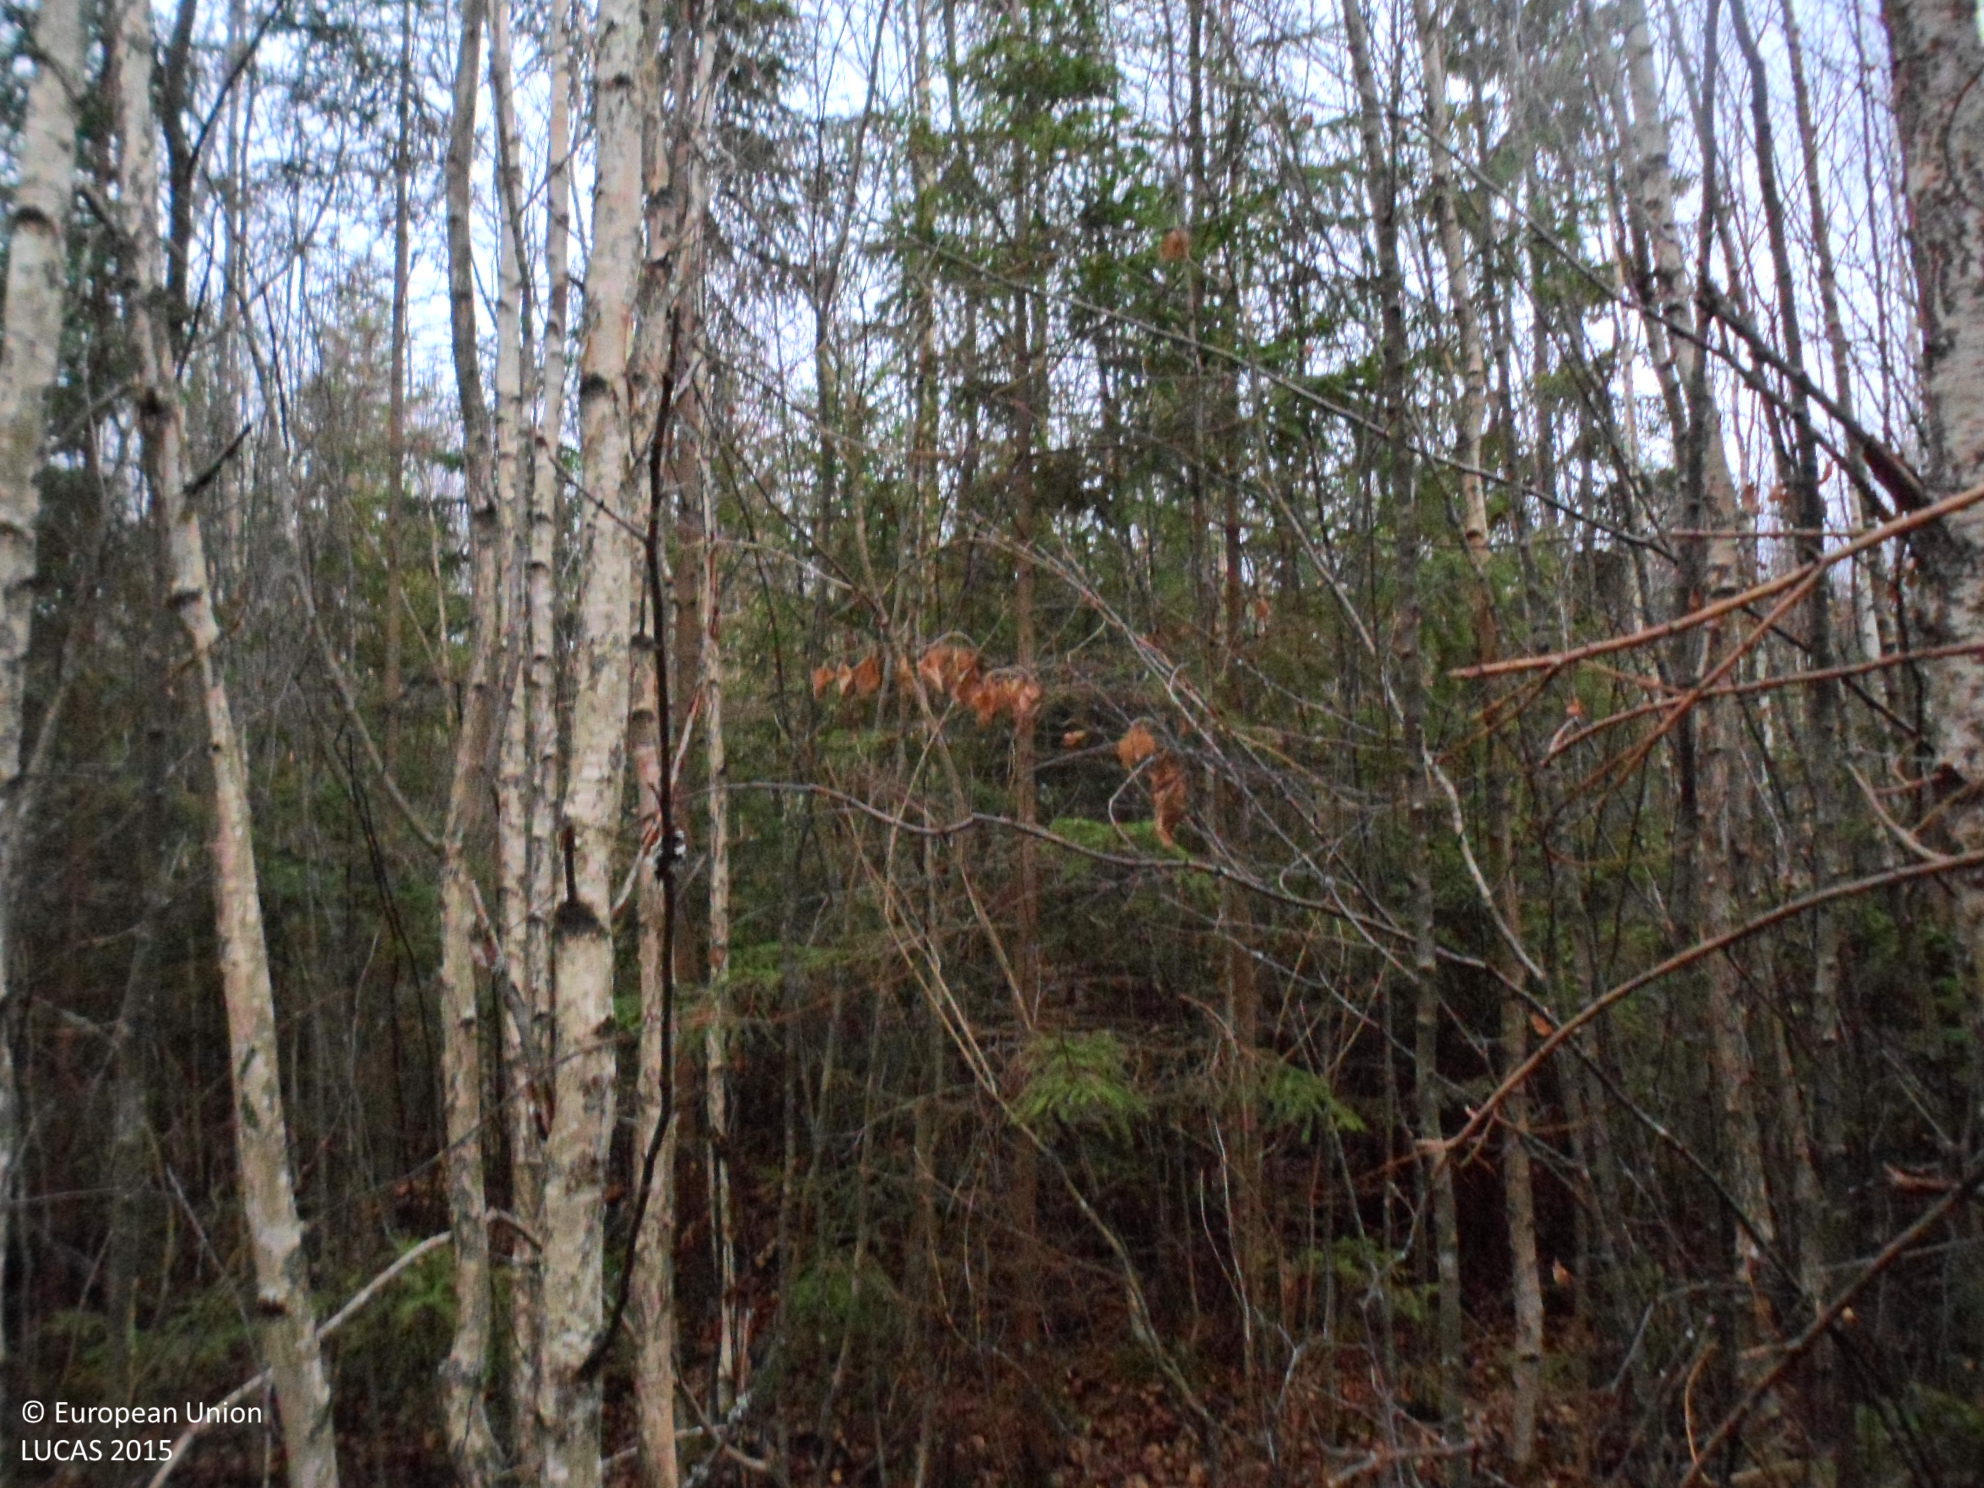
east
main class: Woodland
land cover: Spruce dominated mixed woodland
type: boreal forest
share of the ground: > 75 %
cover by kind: coniferous forest trees 45 %, broadleaved forest trees 30 %, shrubs 10 %, lichens and mosses 10 %, herbaceous plants 5 %
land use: Forestry
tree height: > 5 m
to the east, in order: Spruce dominated mixed woodland; Ditches and canals; Spruce dominated coniferous woodland; Spruce dominated mixed woodland
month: November
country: SE
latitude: 56.7701
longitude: 15.9716
